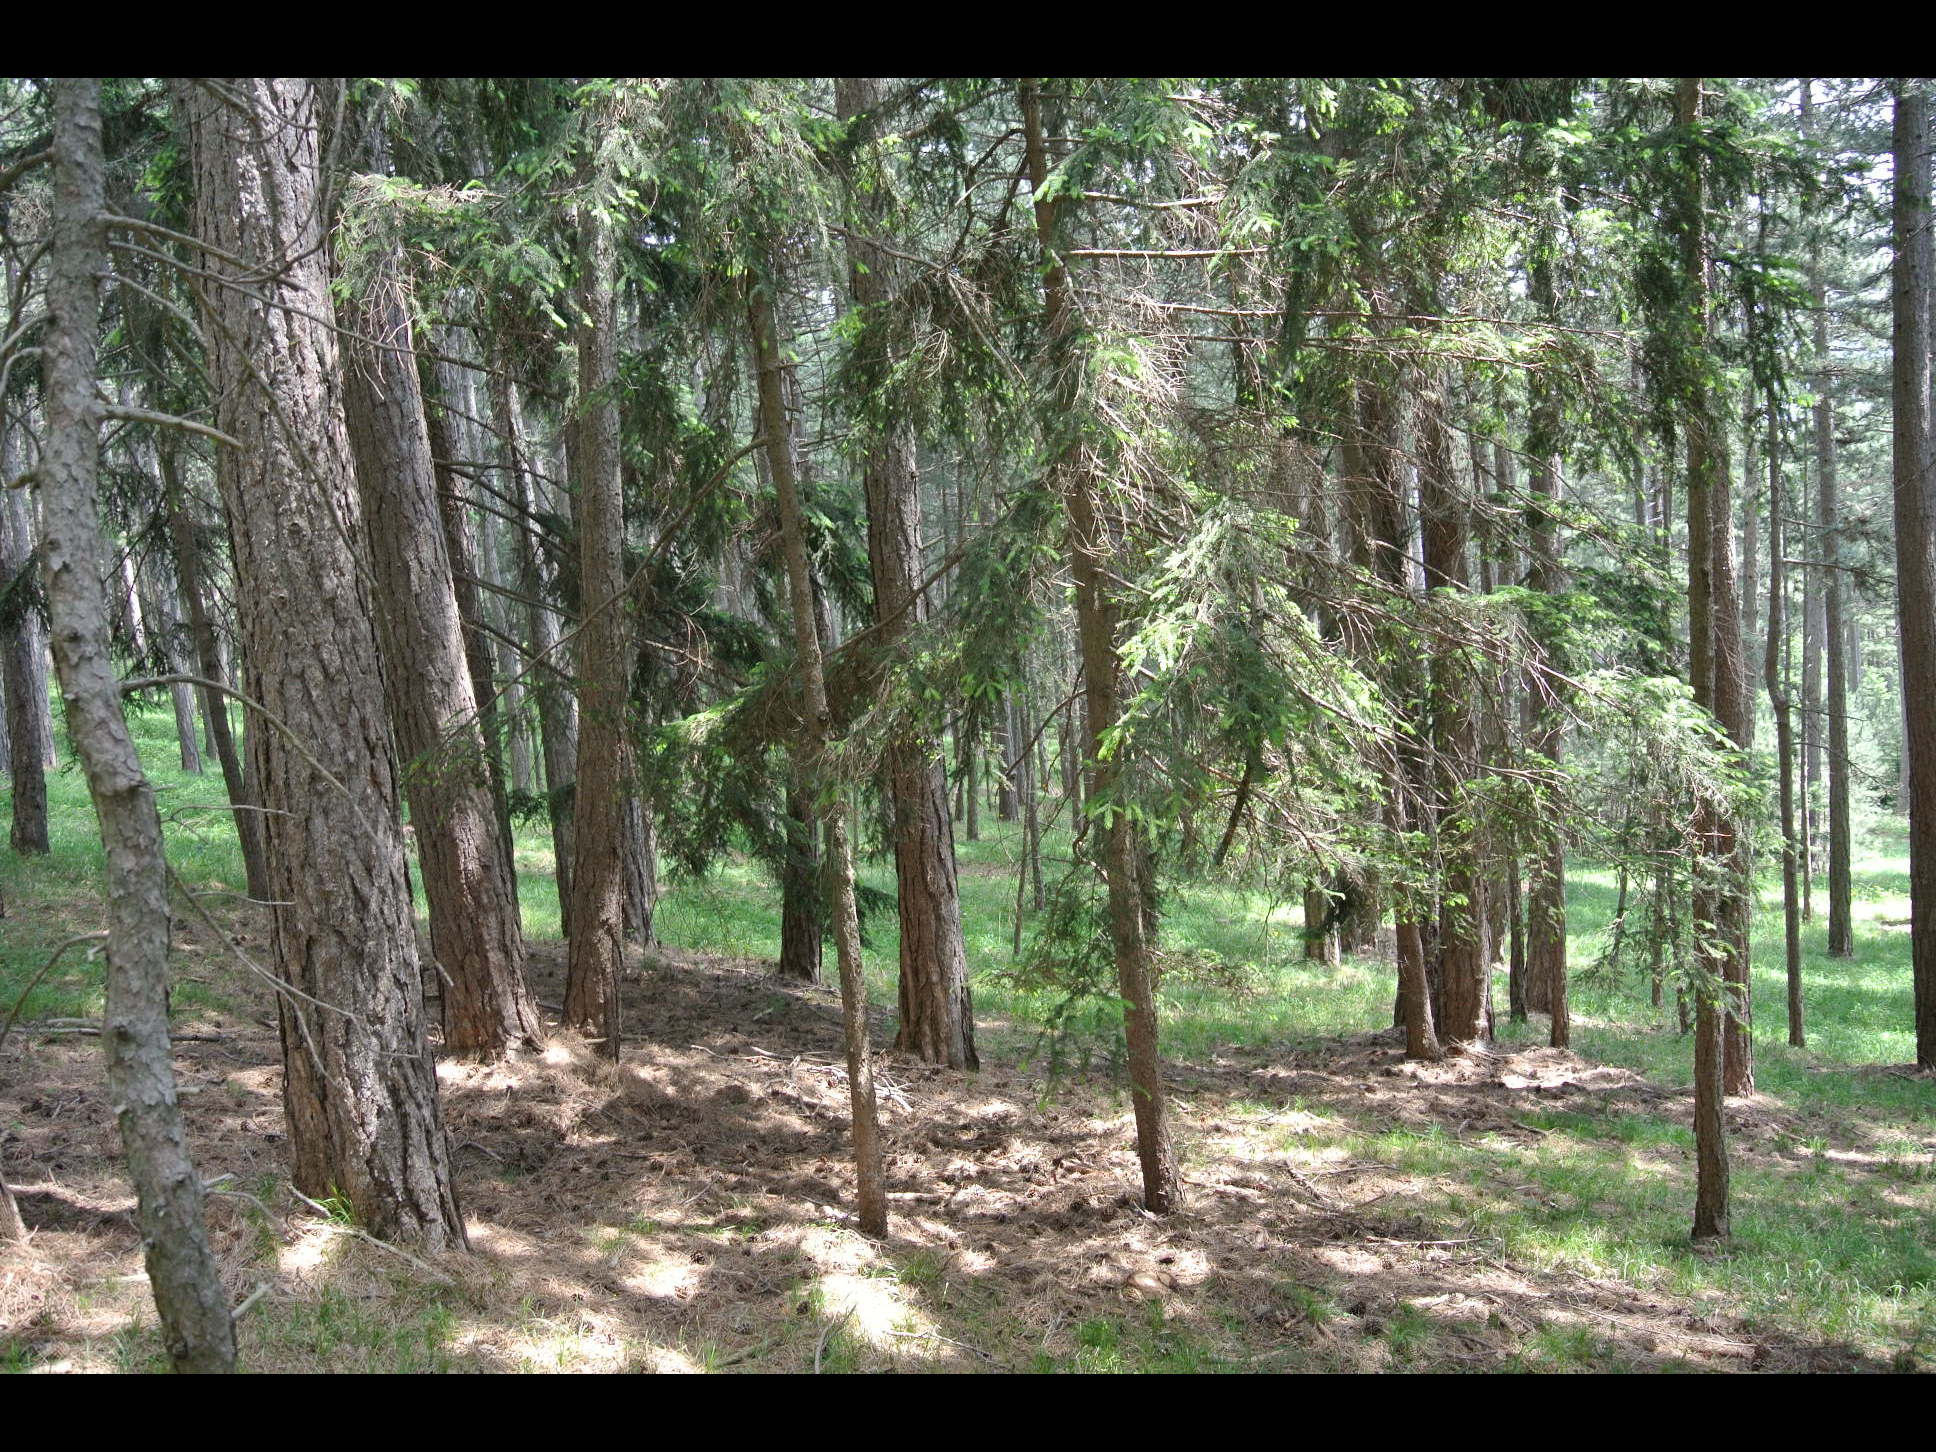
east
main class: Woodland
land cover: Pine dominated coniferous woodland
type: alpine coniferous forest
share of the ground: > 75 %
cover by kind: coniferous forest trees 85 %, herbaceous plants 15 %
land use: Forestry
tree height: > 5 m
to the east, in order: Pine dominated coniferous woodland; Other coniferous woodland; Pine dominated coniferous woodland; Fences; Grassland without tree/shrub cover; Broadleaved woodland; Fences; Tracks; Pine dominated coniferous woodland
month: May
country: AT
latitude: 47.8061
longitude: 16.0251
